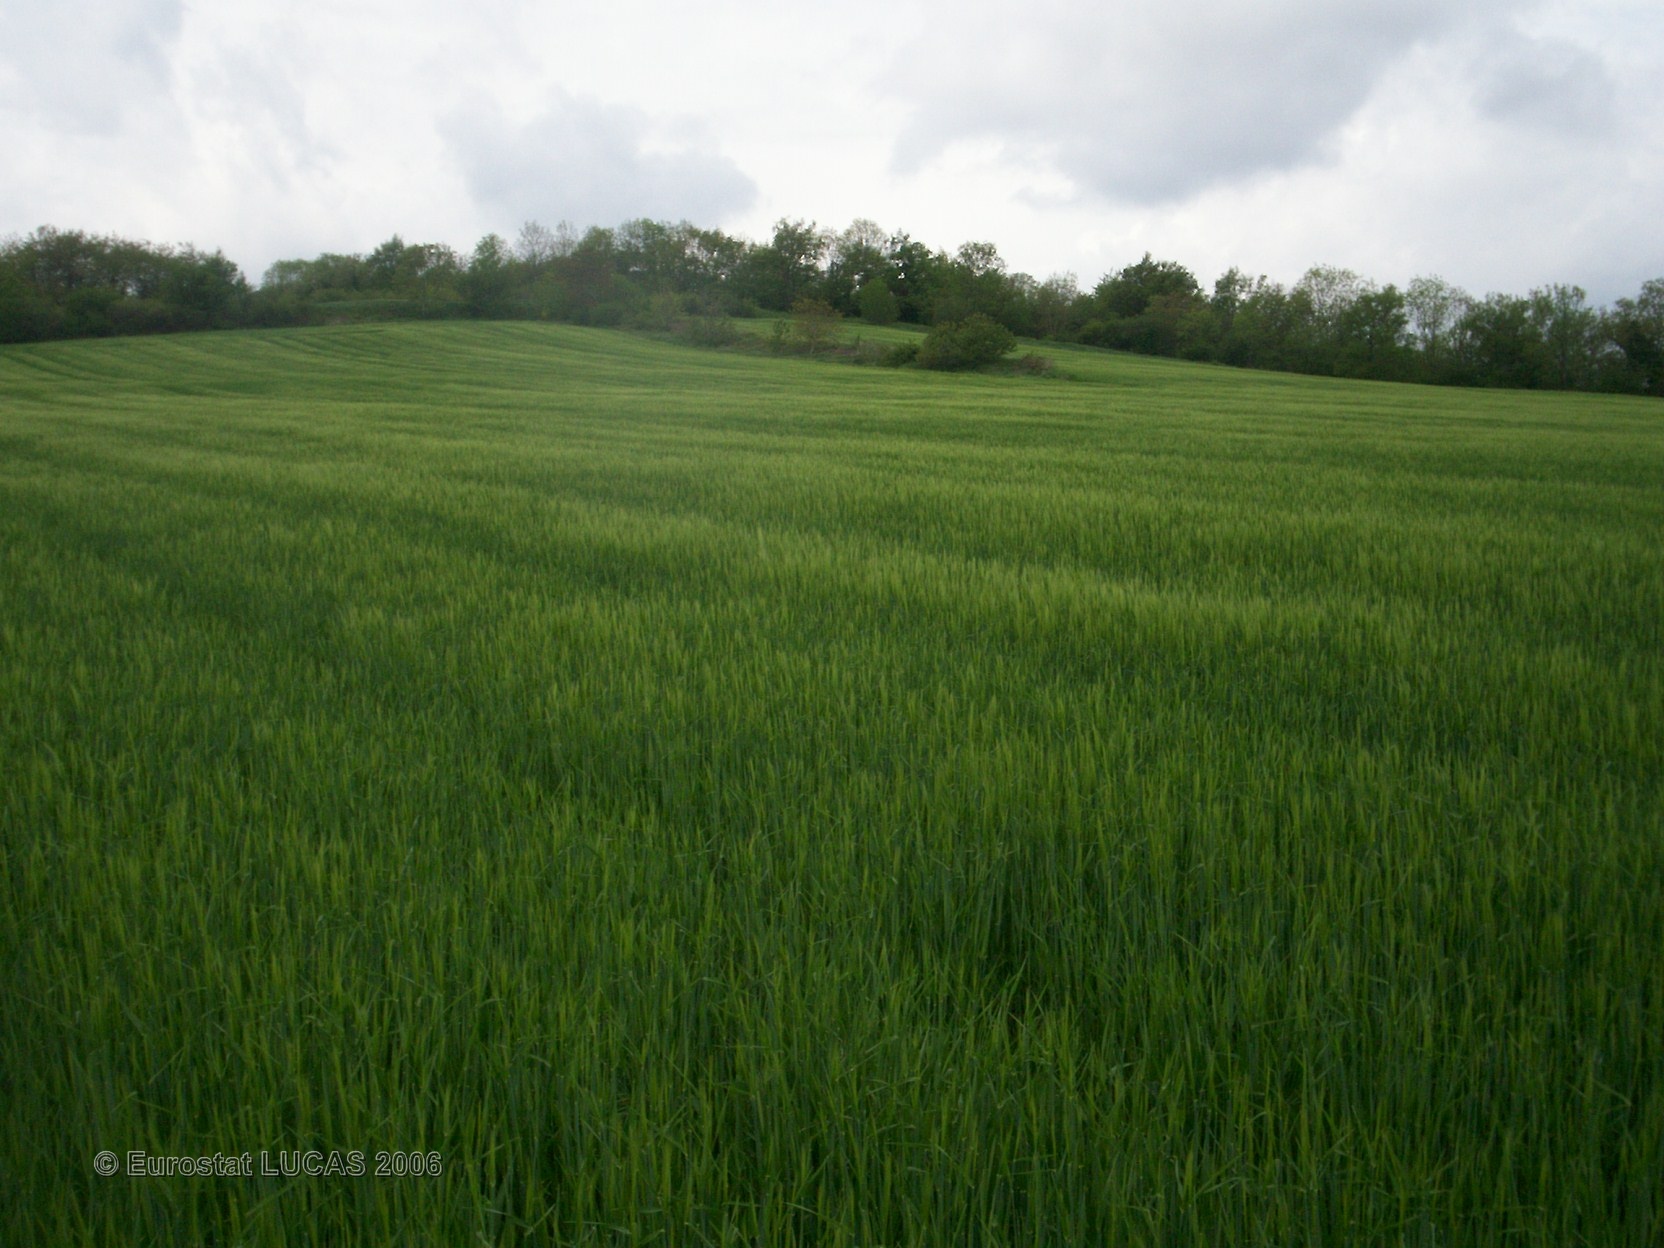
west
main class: Cropland
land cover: Barley
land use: Agriculture (excluding fallow land and kitchen gardens)
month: May
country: FR
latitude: 45.6638
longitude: 3.1850
